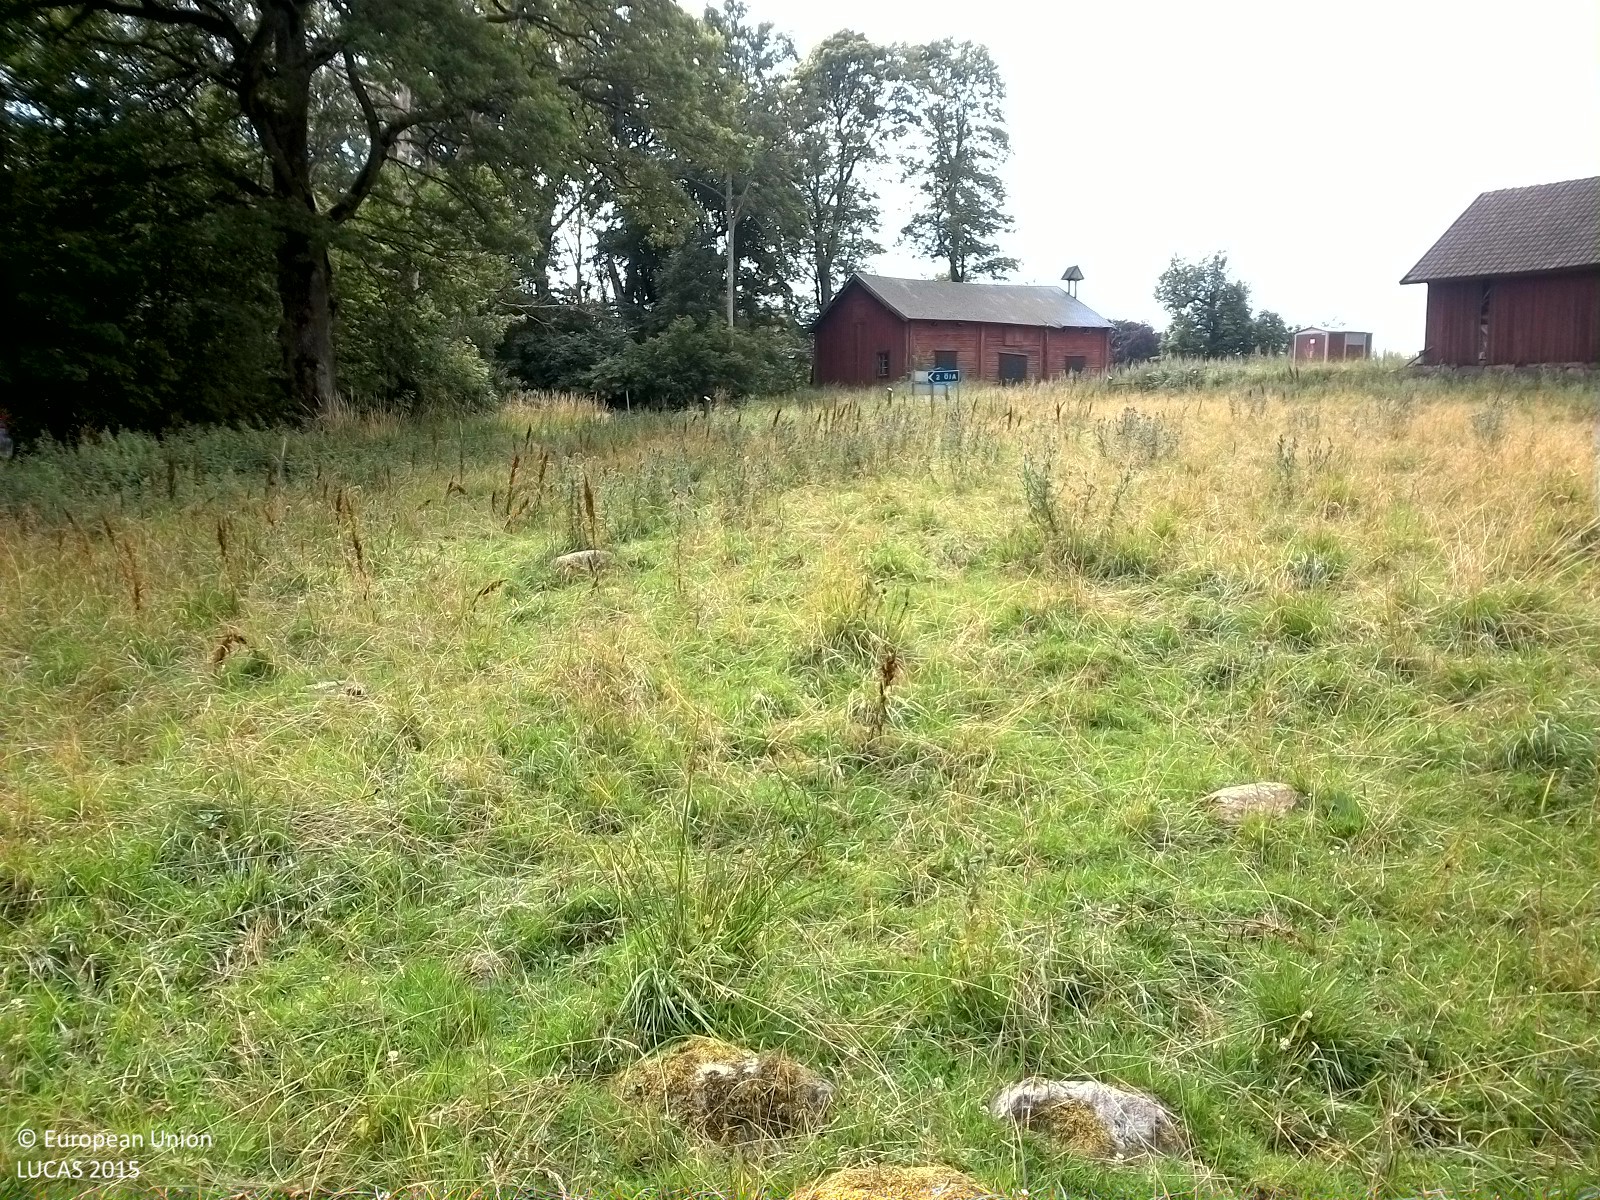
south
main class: Grassland
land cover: Grassland without tree/shrub cover
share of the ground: > 75 %
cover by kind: herbaceous plants 100 %
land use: Agriculture (excluding fallow land and kitchen gardens)
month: August
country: SE
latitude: 59.1204
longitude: 14.9356
